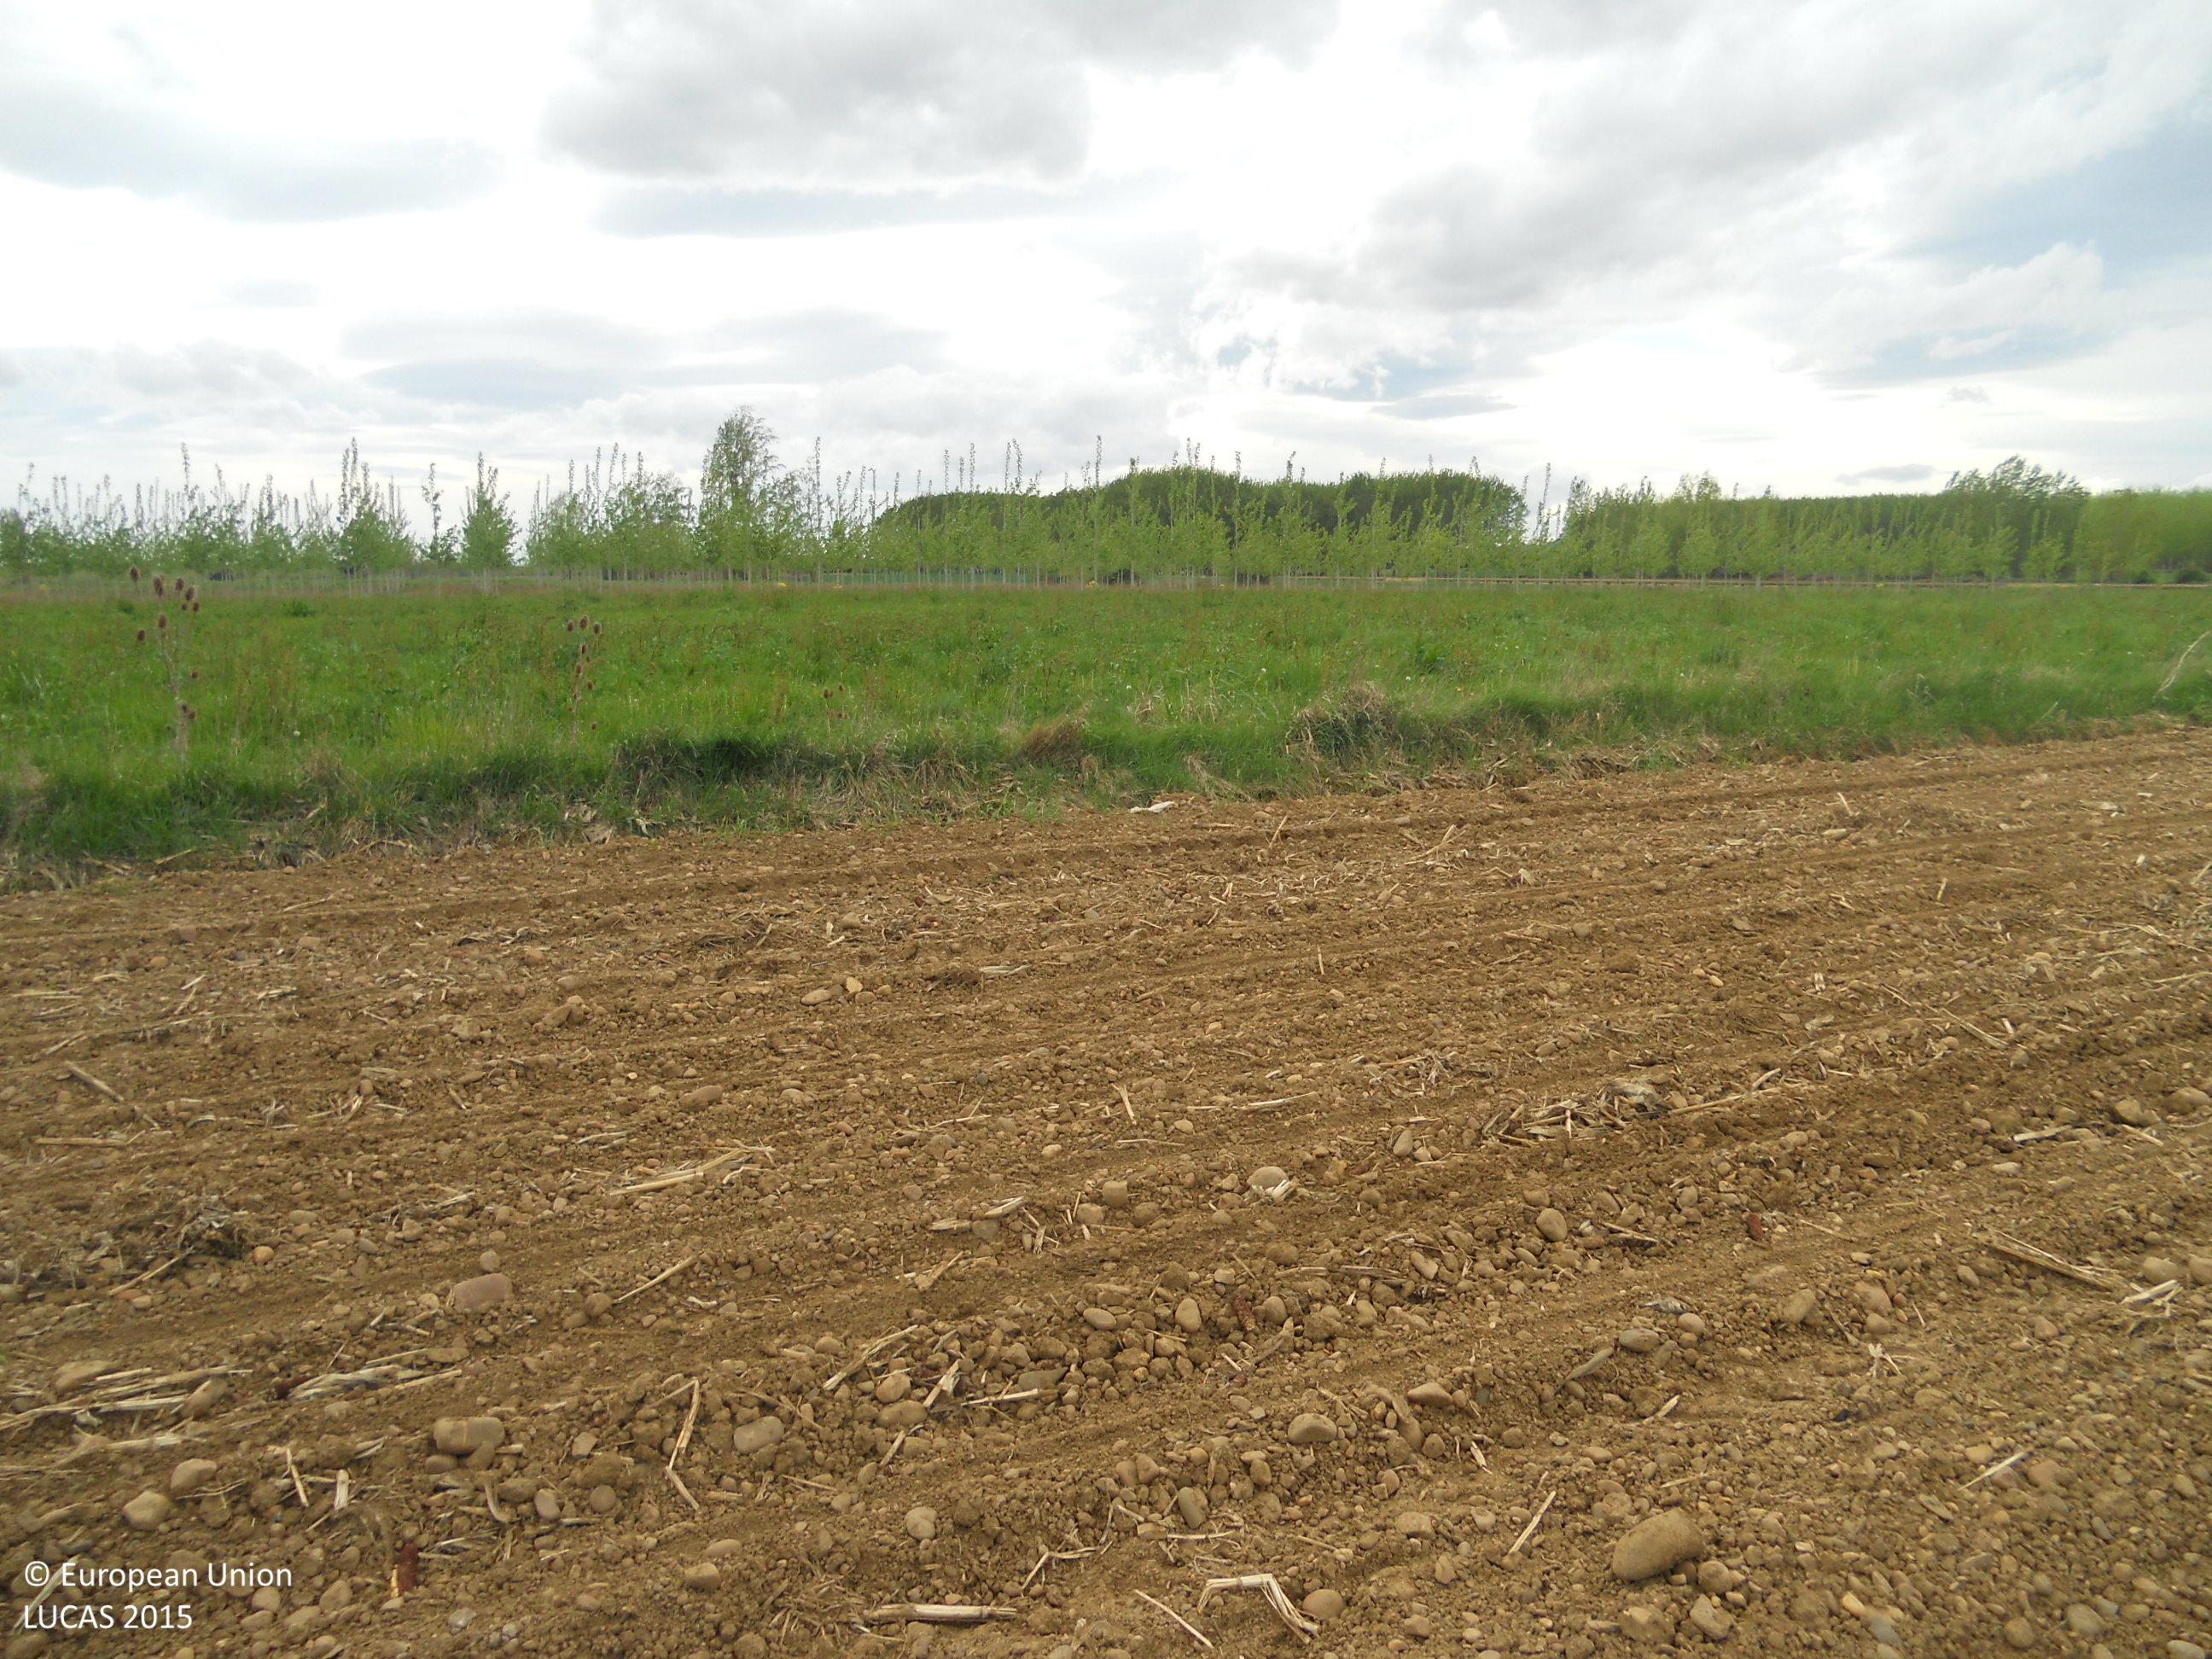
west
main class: Cropland
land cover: Maize
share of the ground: < 10 %
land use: Agriculture (excluding fallow land and kitchen gardens)
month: May
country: ES
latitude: 42.5263
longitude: -5.3203
